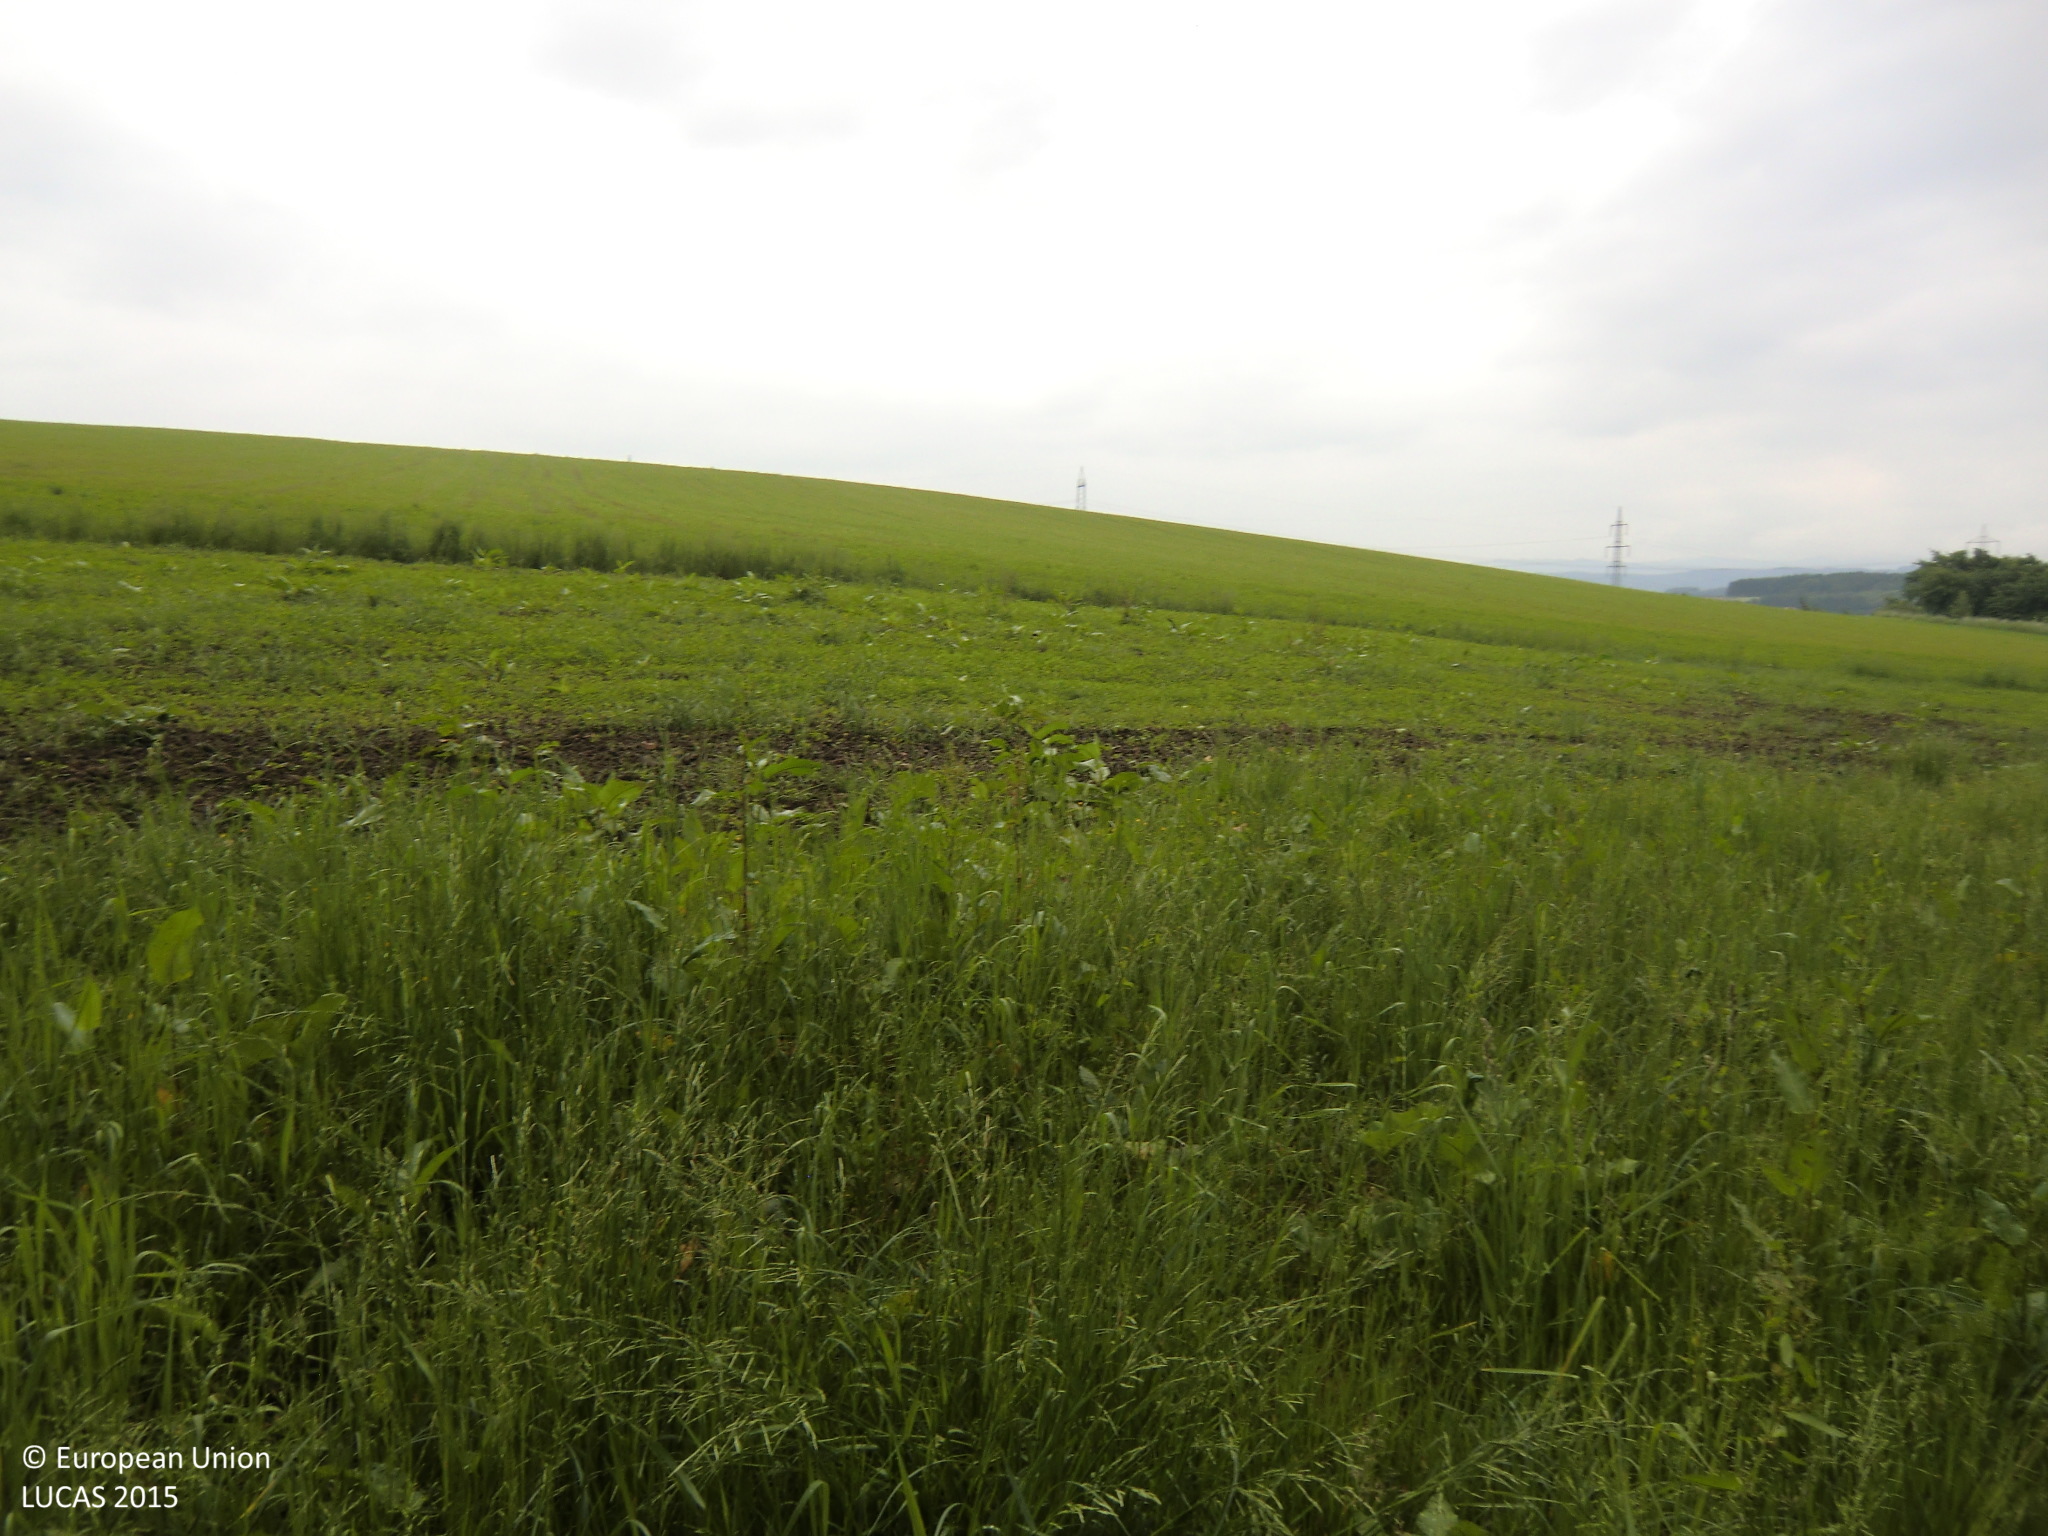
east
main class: Grassland
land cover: Grassland without tree/shrub cover
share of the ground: > 75 %
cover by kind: herbaceous plants 100 %
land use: Agriculture (excluding fallow land and kitchen gardens)
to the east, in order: Grassland without tree/shrub cover; Clovers; Grass margins; Clovers
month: May
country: AT
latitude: 48.1637
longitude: 15.3934
